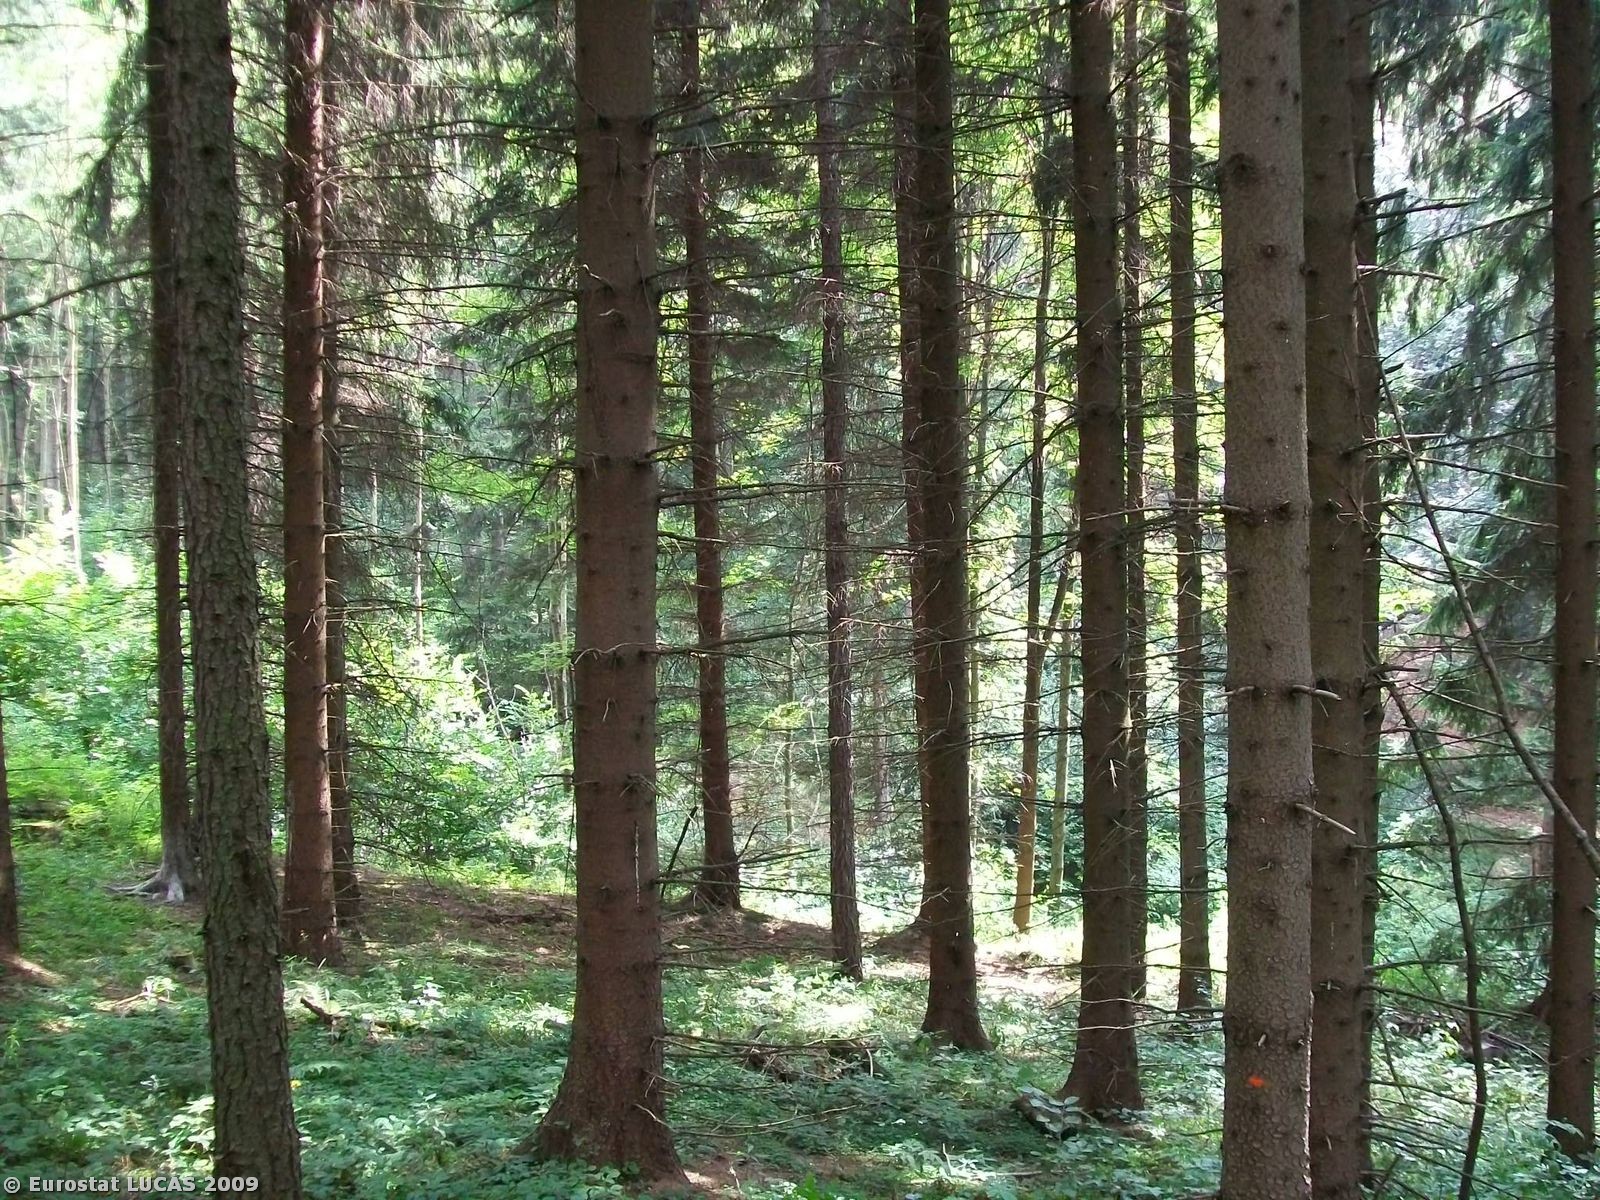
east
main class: Woodland
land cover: Mixed woodland
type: hemiboreal forest and nemoral coniferous forest and mixed broadleaved-coniferous forest
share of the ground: > 75 %
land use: Forestry
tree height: > 5 m
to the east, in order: Mixed woodland; Rivers and streams; Mixed woodland; Paved roads, cycling and walking lanes; Ditches and canals; Mixed woodland; Coniferous woodland
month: September
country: PL
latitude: 50.4726
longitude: 16.7297
